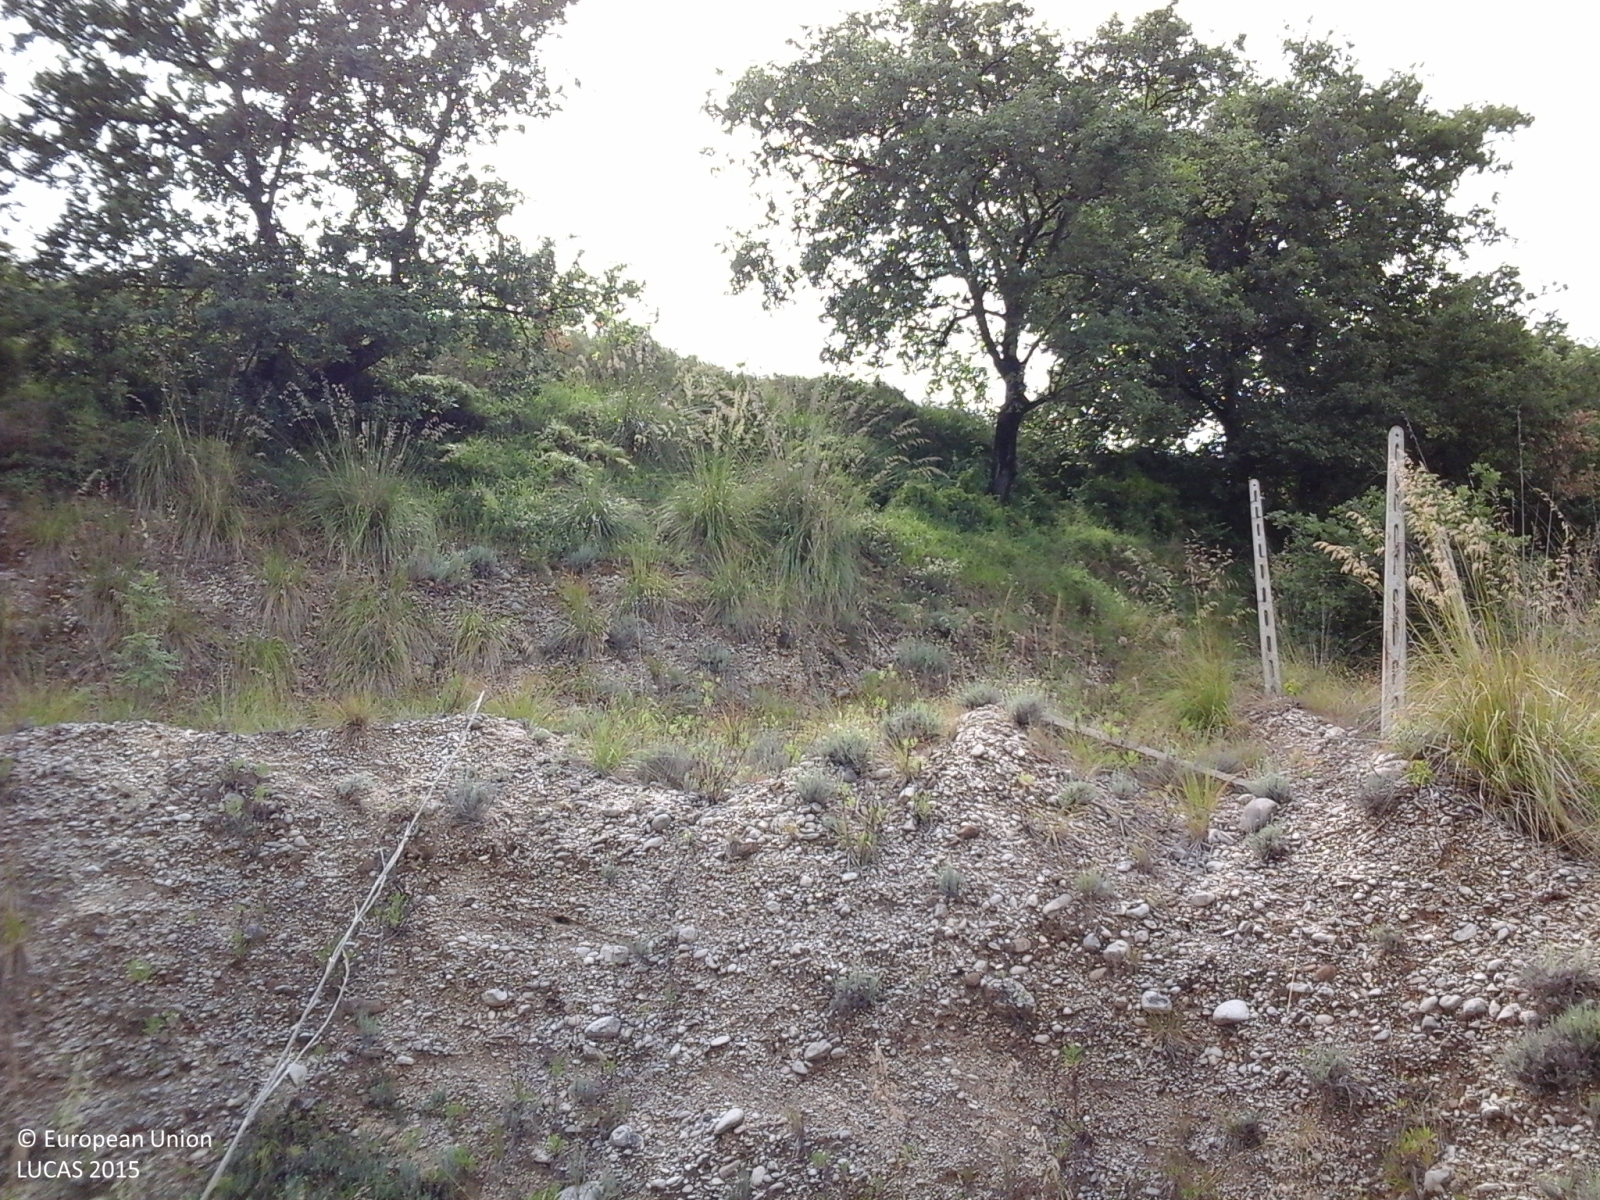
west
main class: Cropland
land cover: Vineyards
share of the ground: 50 - 75 %
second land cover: Spontaneously vegetated surfaces
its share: > 75 %
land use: Abandoned areas
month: May
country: IT
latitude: 42.9974
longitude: 13.8291
